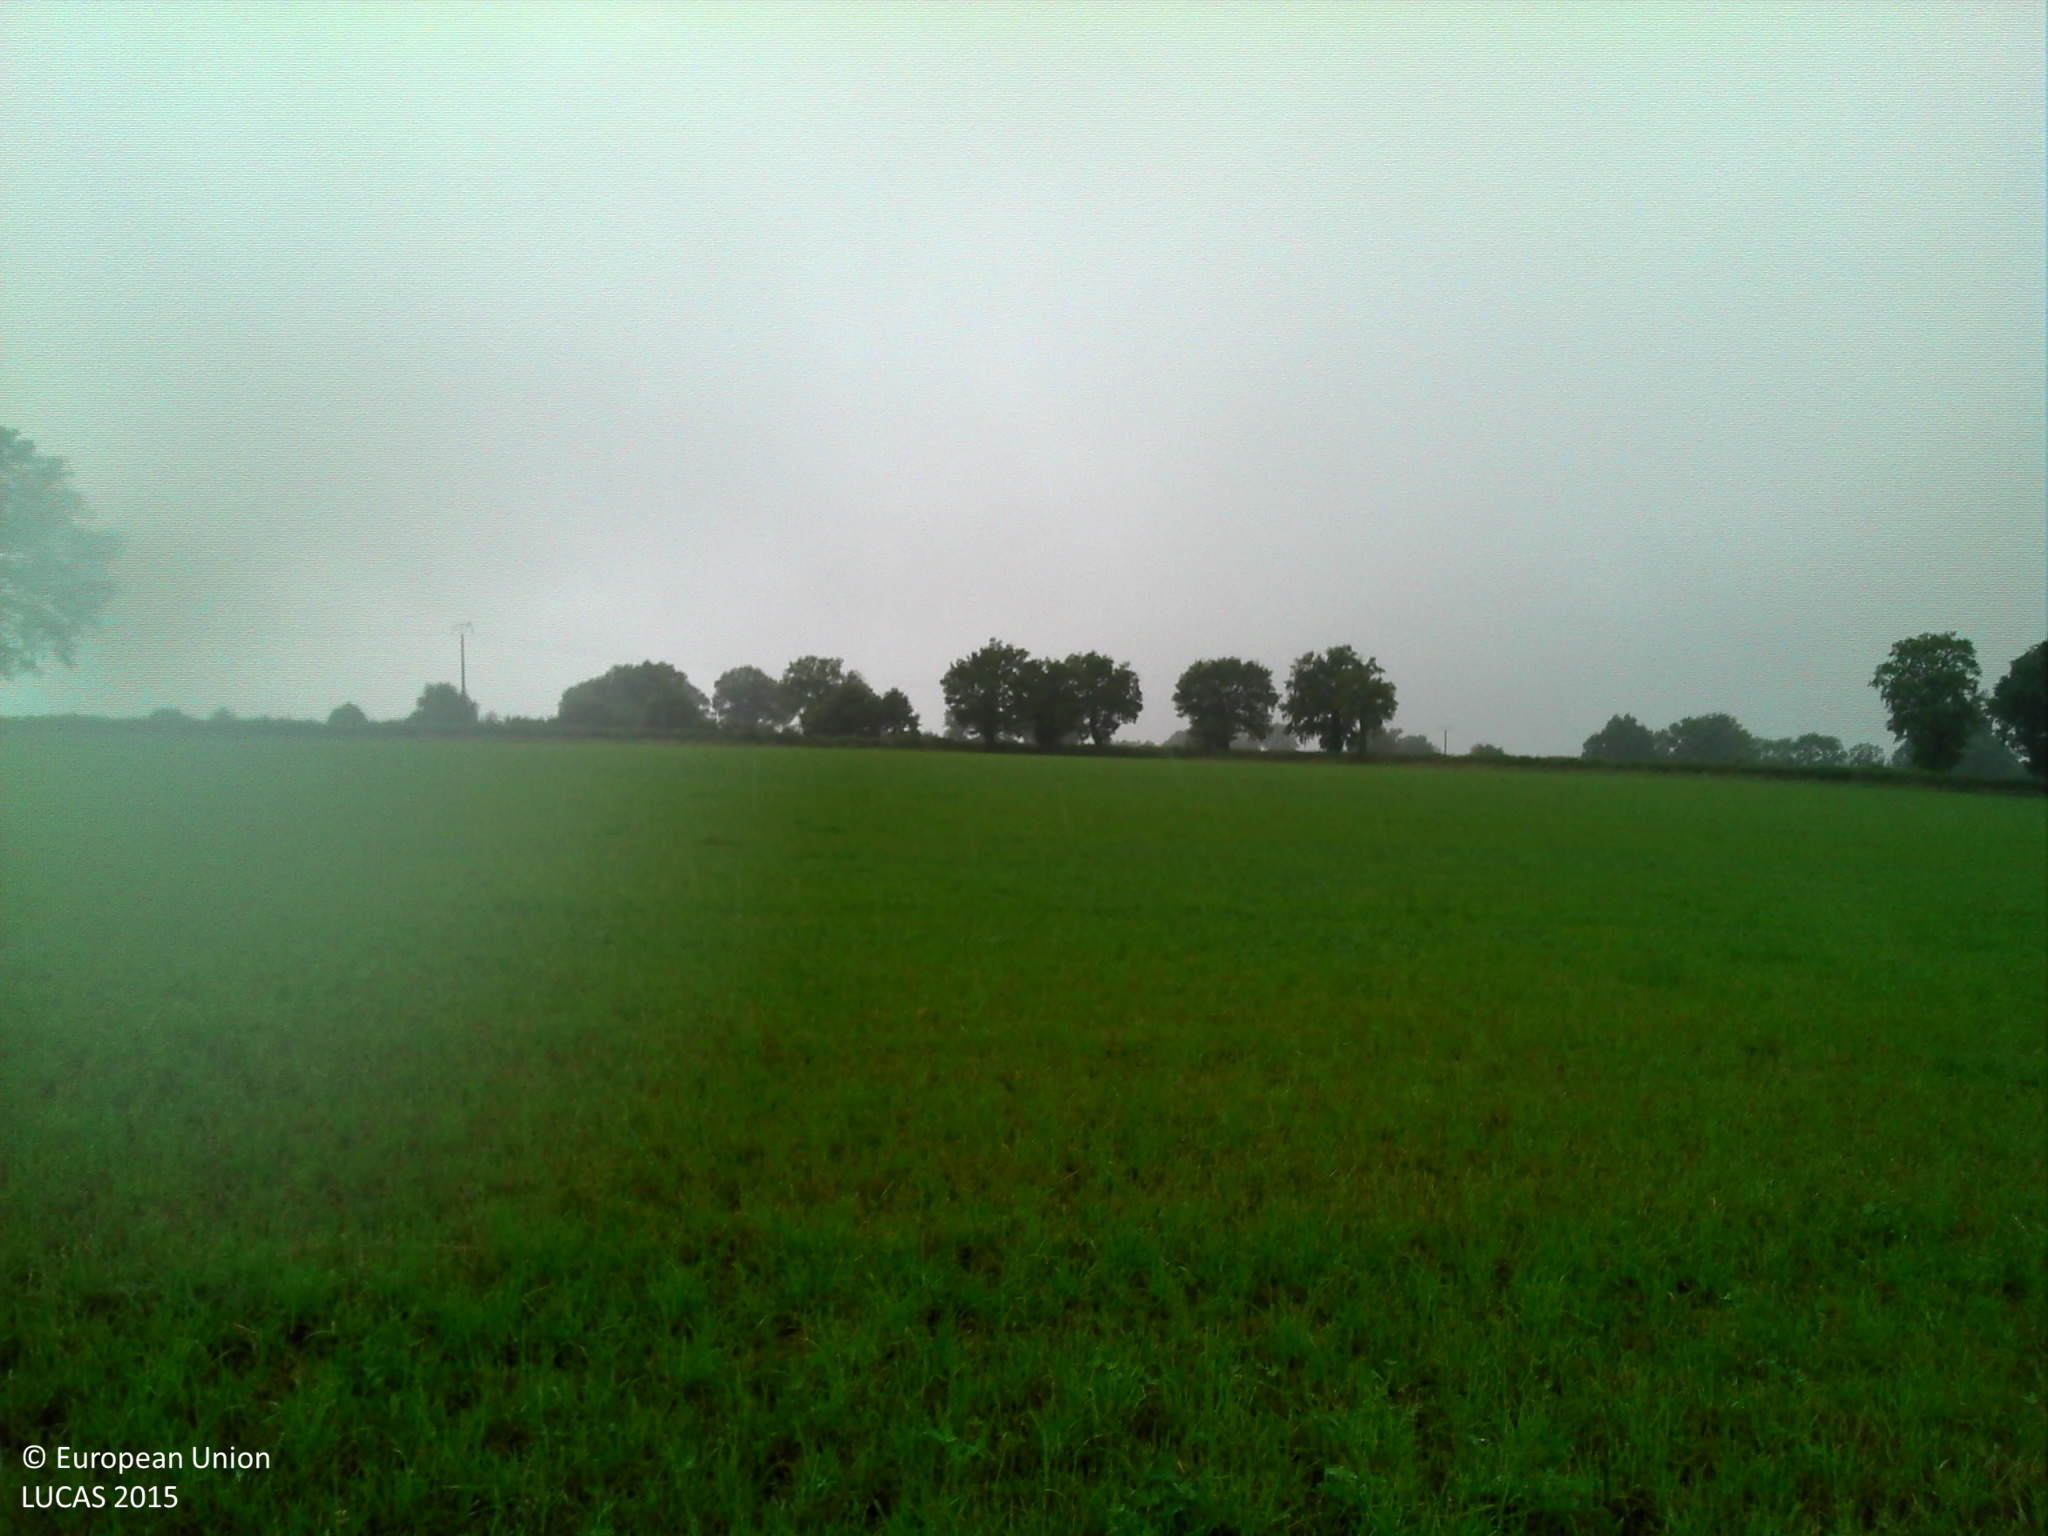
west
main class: Cropland
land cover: Temporary grasslands
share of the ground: > 75 %
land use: Agriculture (excluding fallow land and kitchen gardens)
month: June
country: FR
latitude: 46.4459
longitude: 2.9809
